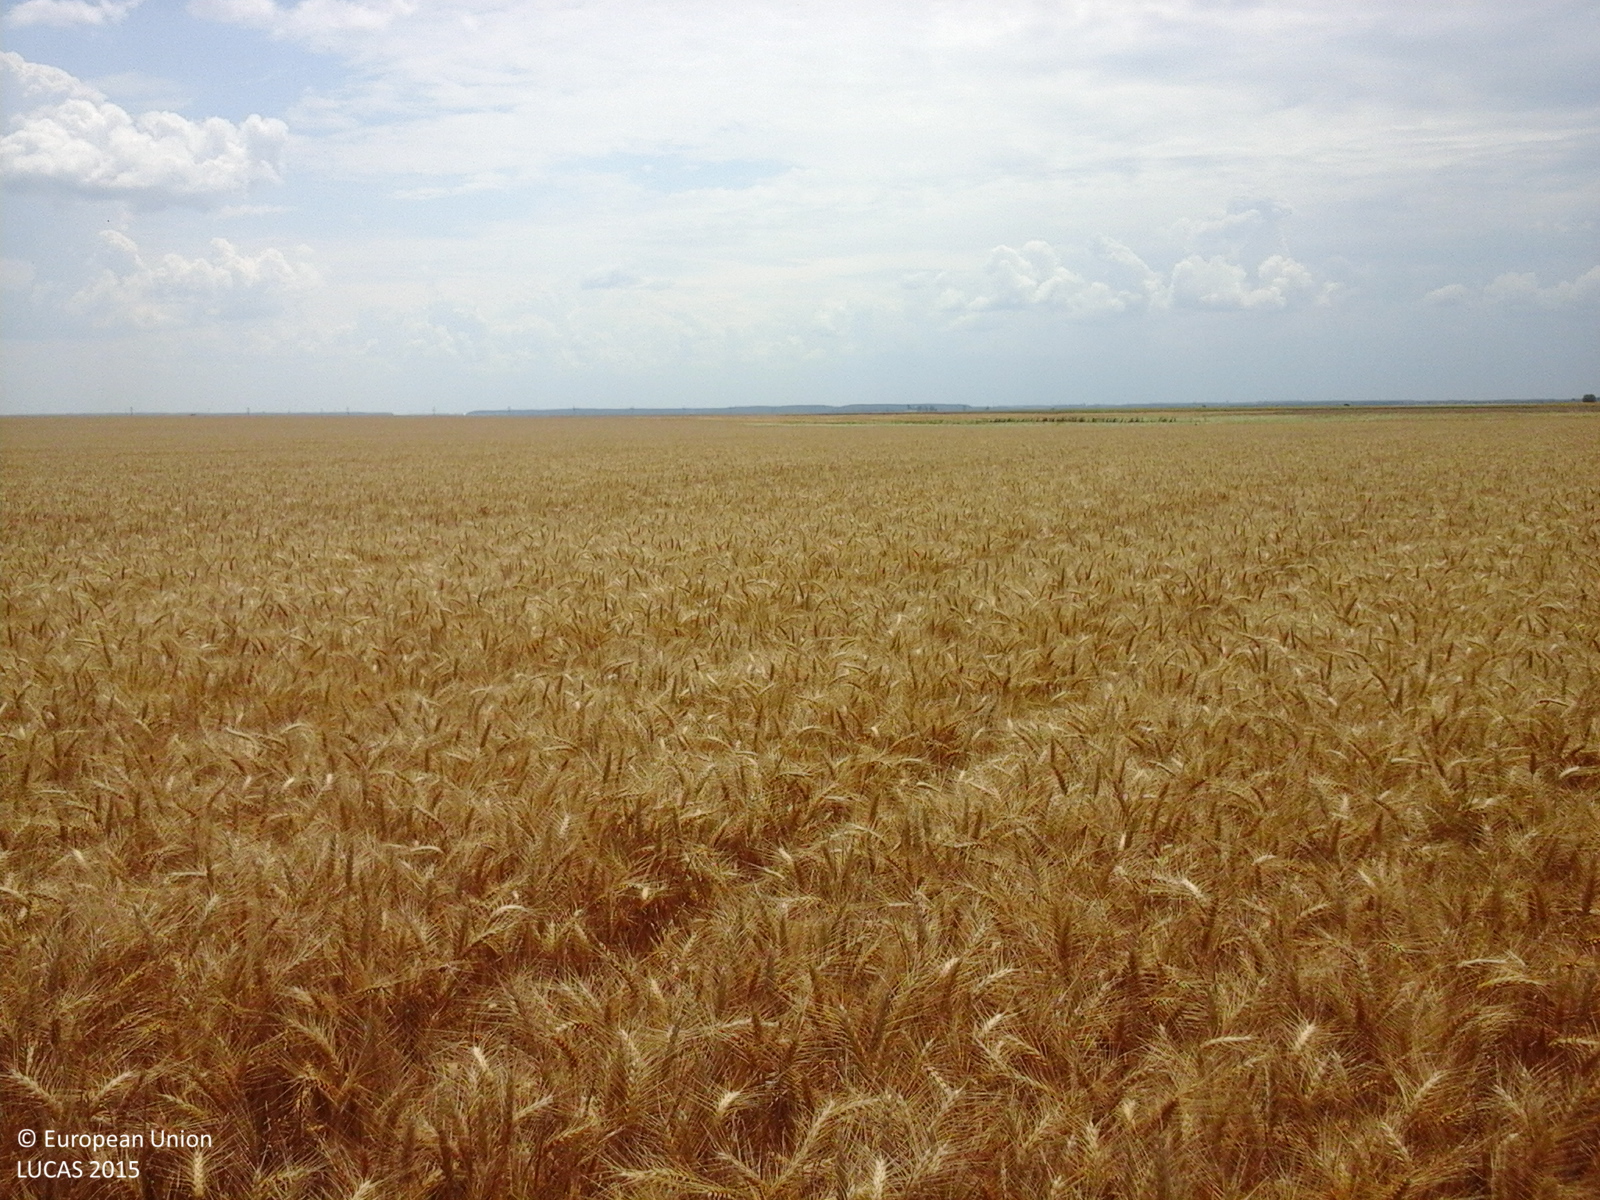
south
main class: Cropland
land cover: Common wheat
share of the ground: > 75 %
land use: Agriculture (excluding fallow land and kitchen gardens)
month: June
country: RO
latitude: 44.2353
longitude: 26.0145
